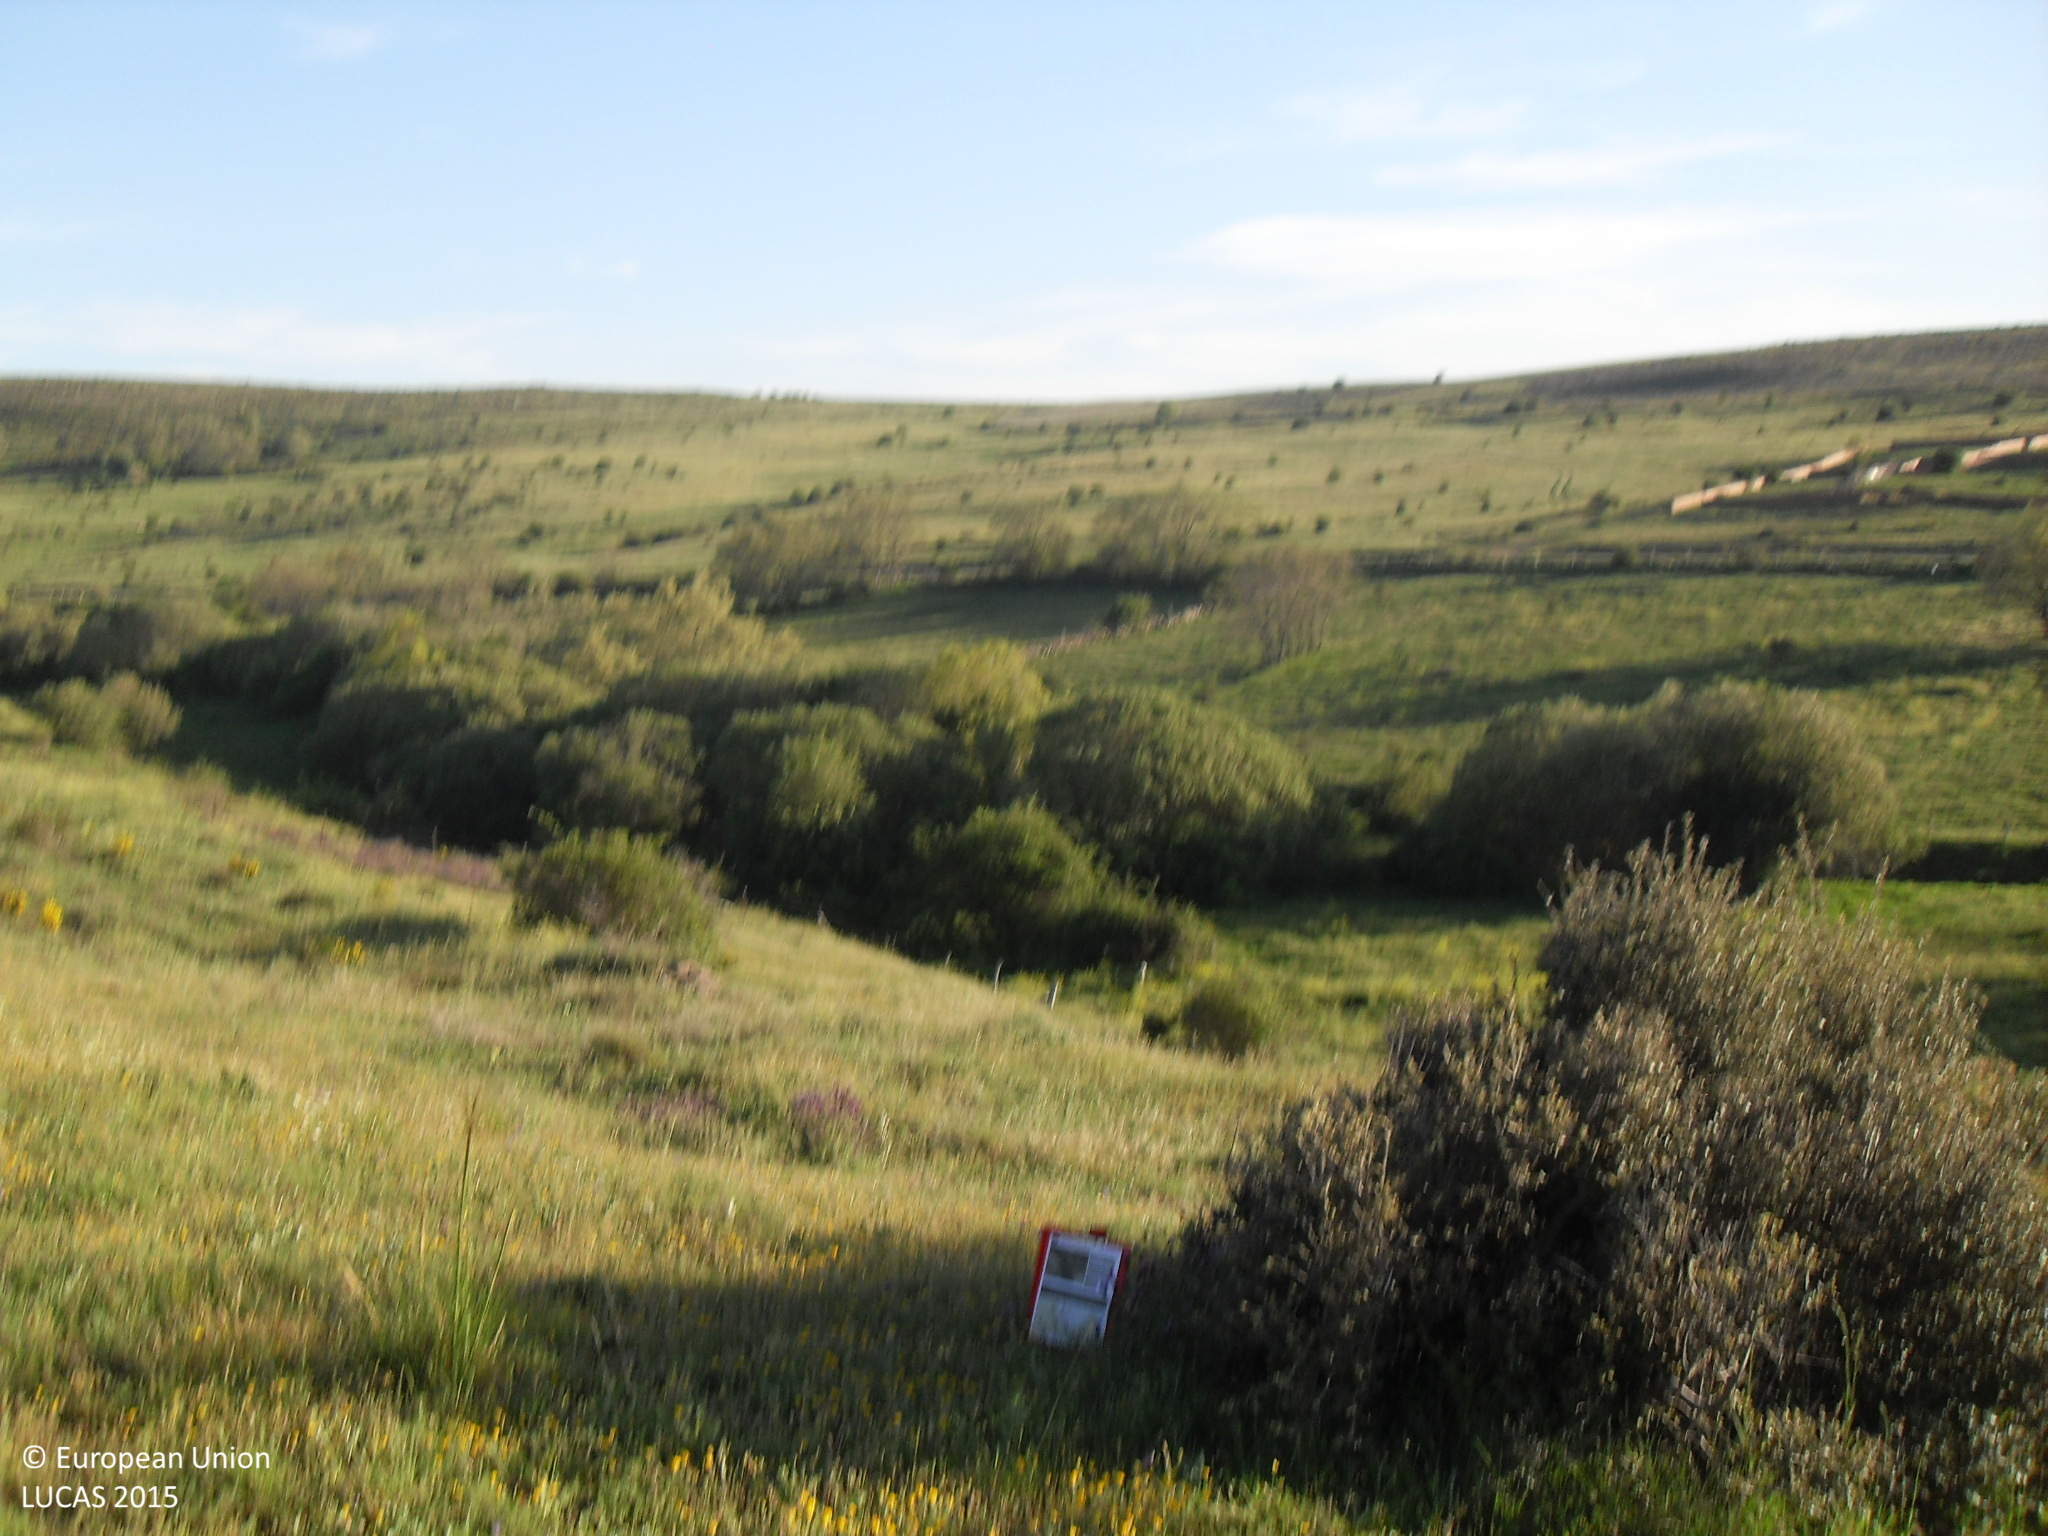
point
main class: Grassland
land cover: Grassland with sparse tree/shrub cover
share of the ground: > 75 %
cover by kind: herbaceous plants 95 %, broadleaved forest trees 5 %
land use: Agriculture (excluding fallow land and kitchen gardens)
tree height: < 5 m
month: May
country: ES
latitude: 40.6884
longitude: -5.1025
